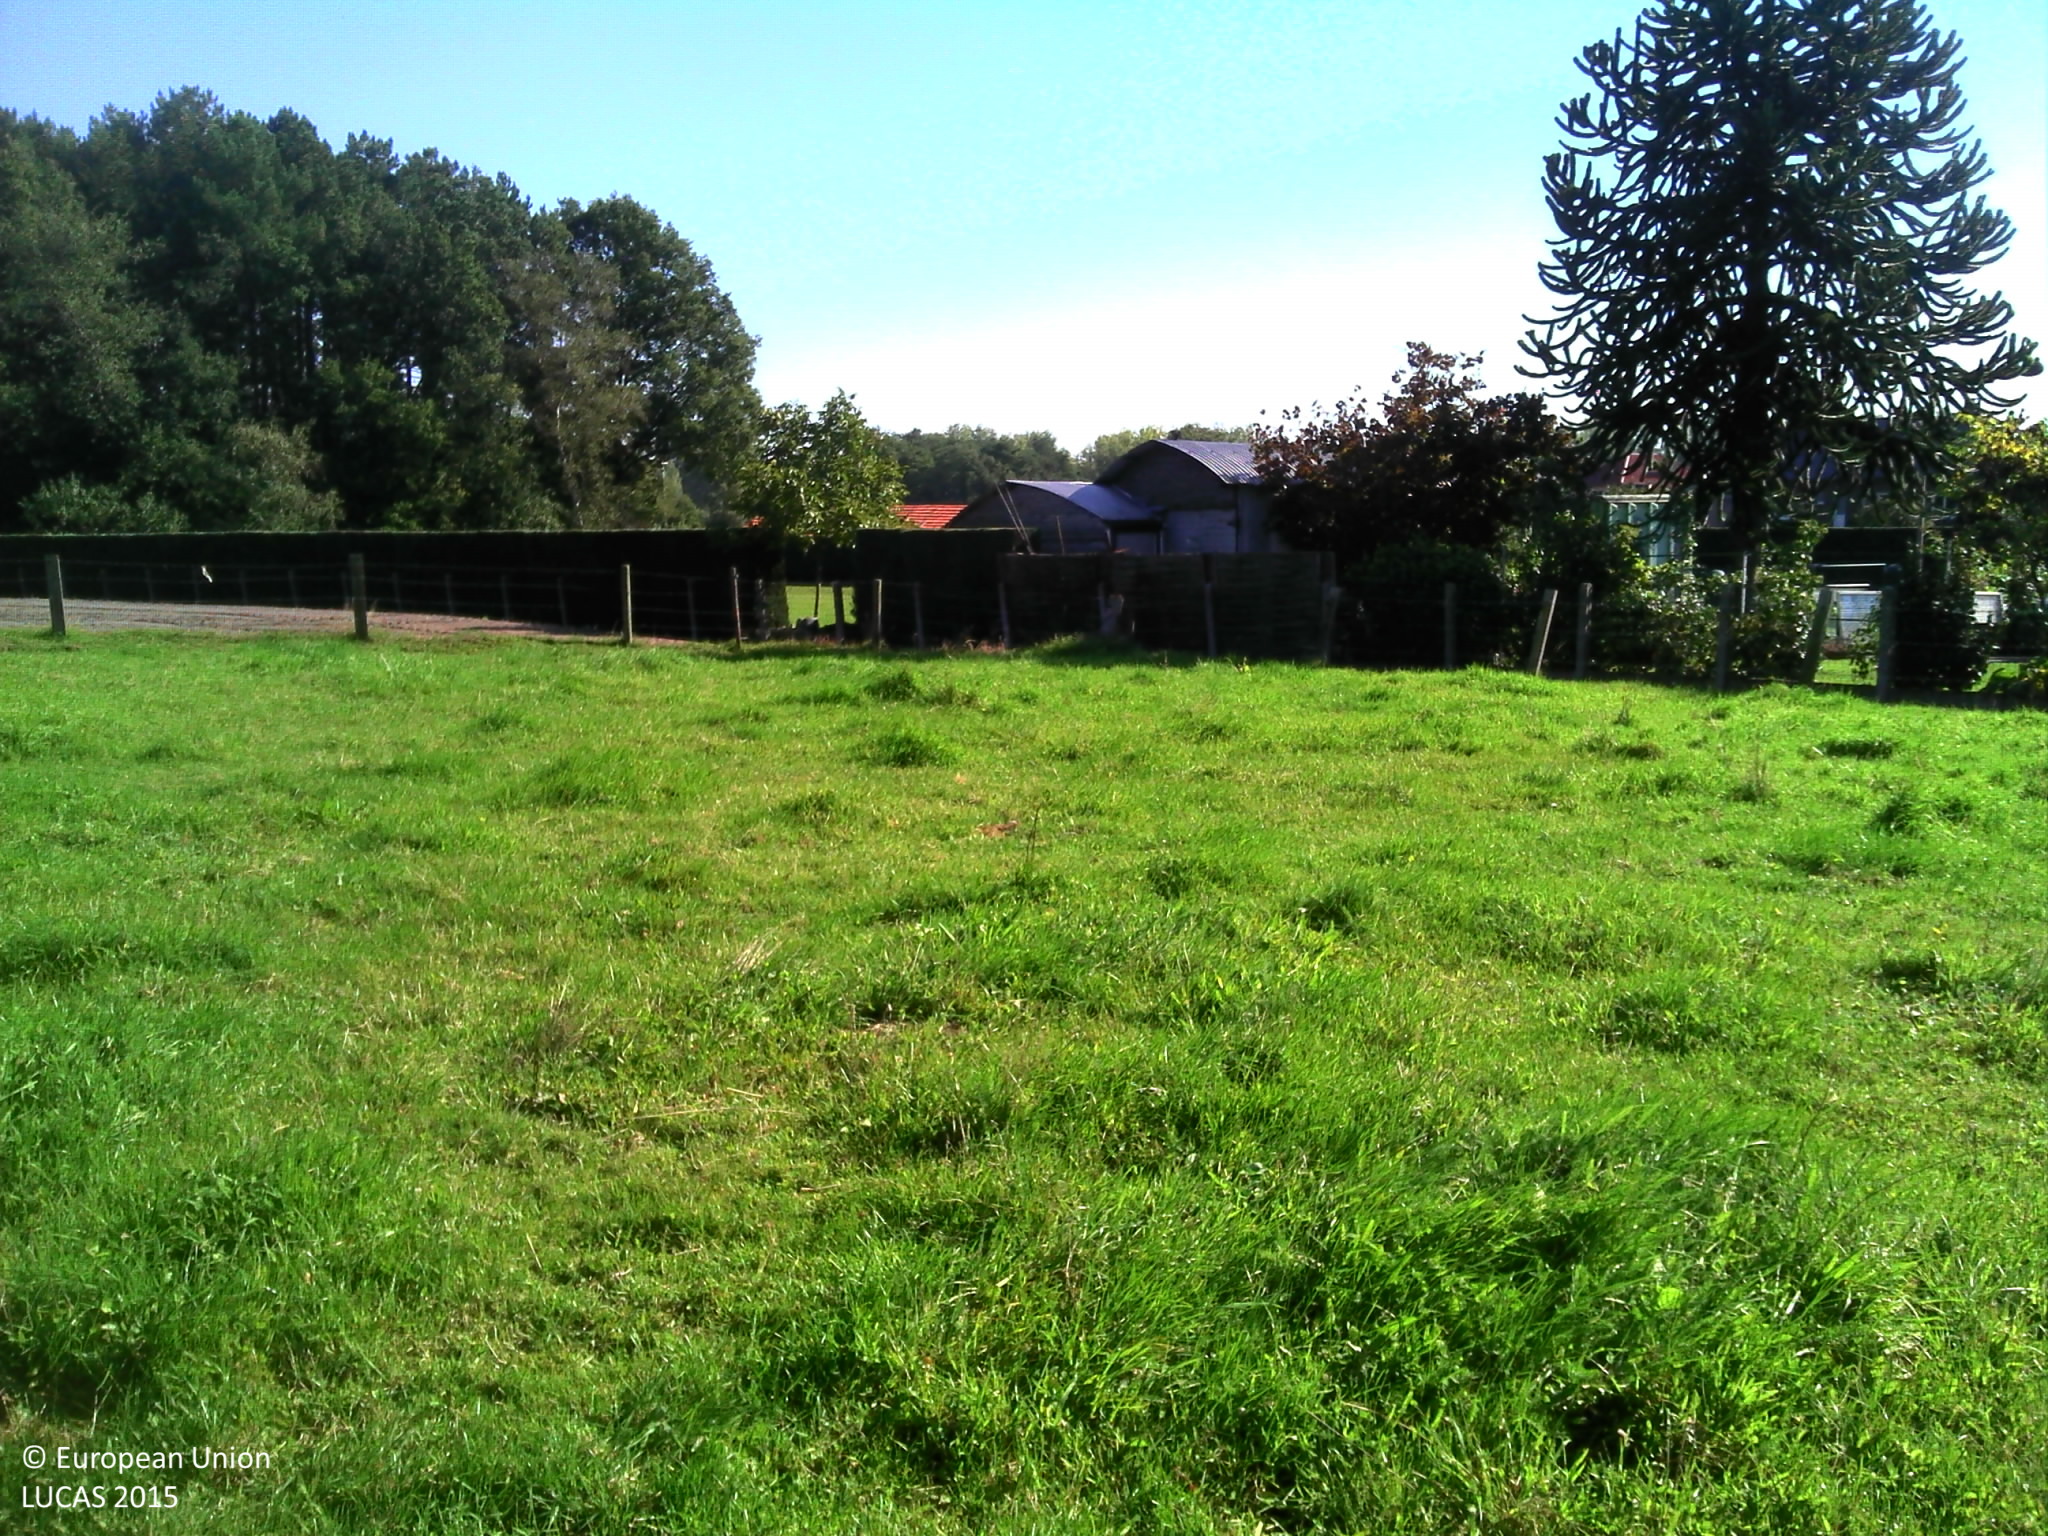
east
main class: Grassland
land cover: Grassland without tree/shrub cover
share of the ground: > 75 %
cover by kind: herbaceous plants 100 %
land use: Agriculture (excluding fallow land and kitchen gardens)
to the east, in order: Grassland without tree/shrub cover; Fences; Other bare soil; Ditches and canals; Artificial constructions in urban areas; Temporary grasslands; Fences; Grassland without tree/shrub cover; Fences; Grassland without tree/shrub cover; Fences; Grassland without tree/shrub cover; Fences; Grassland without tree/shrub cover; Artificial constructions in urban areas
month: September
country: BE
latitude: 51.2546
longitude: 4.7953
